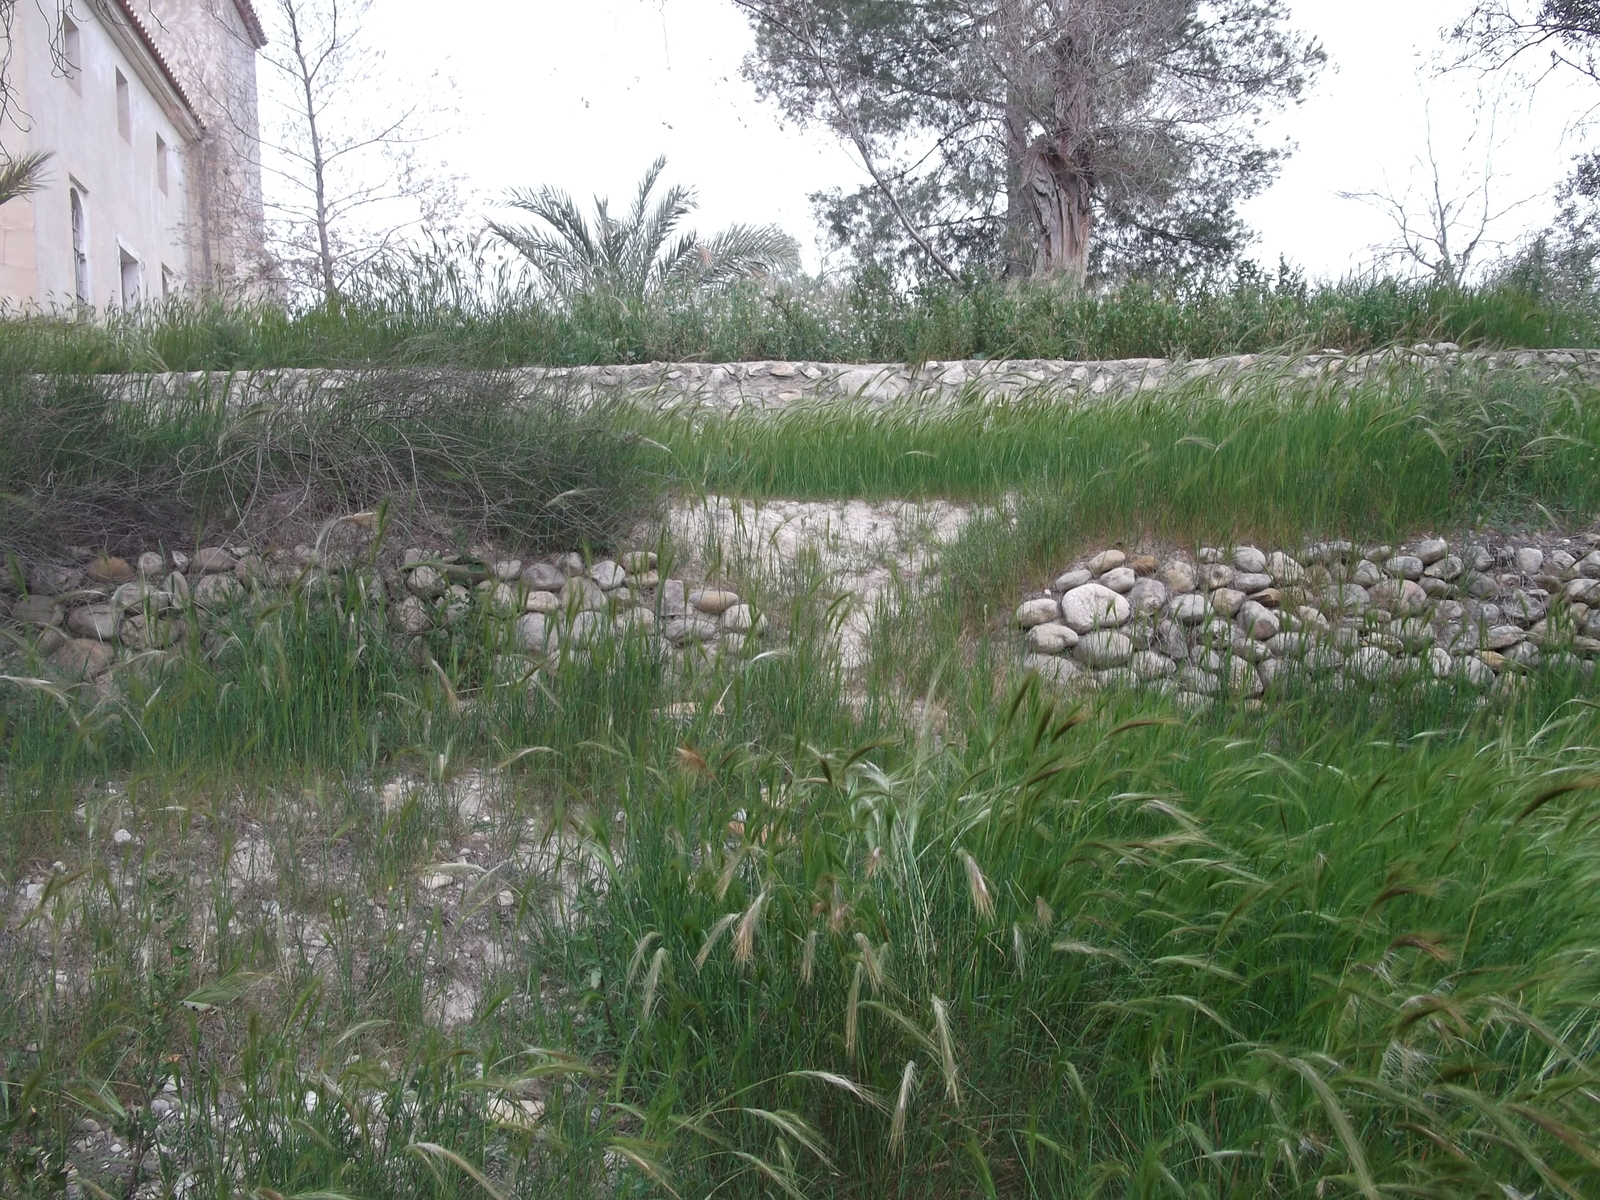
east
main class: Woodland
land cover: Pine dominated mixed woodland
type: coniferous forest of the mediterranean region
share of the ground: 25 - 50 %
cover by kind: consolidated bare surface 50 %, coniferous forest trees 25 %, broadleaved forest trees 25 %
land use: Semi-natural and natural areas not in use
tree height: > 5 m
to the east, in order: Pine dominated mixed woodland; Dry stone walls; Pine dominated mixed woodland; Spontaneously vegetated surfaces; Electric lines; Spontaneously vegetated surfaces; Artificial constructions in urban areas
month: April
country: ES
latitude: 38.0304
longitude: -1.3897
